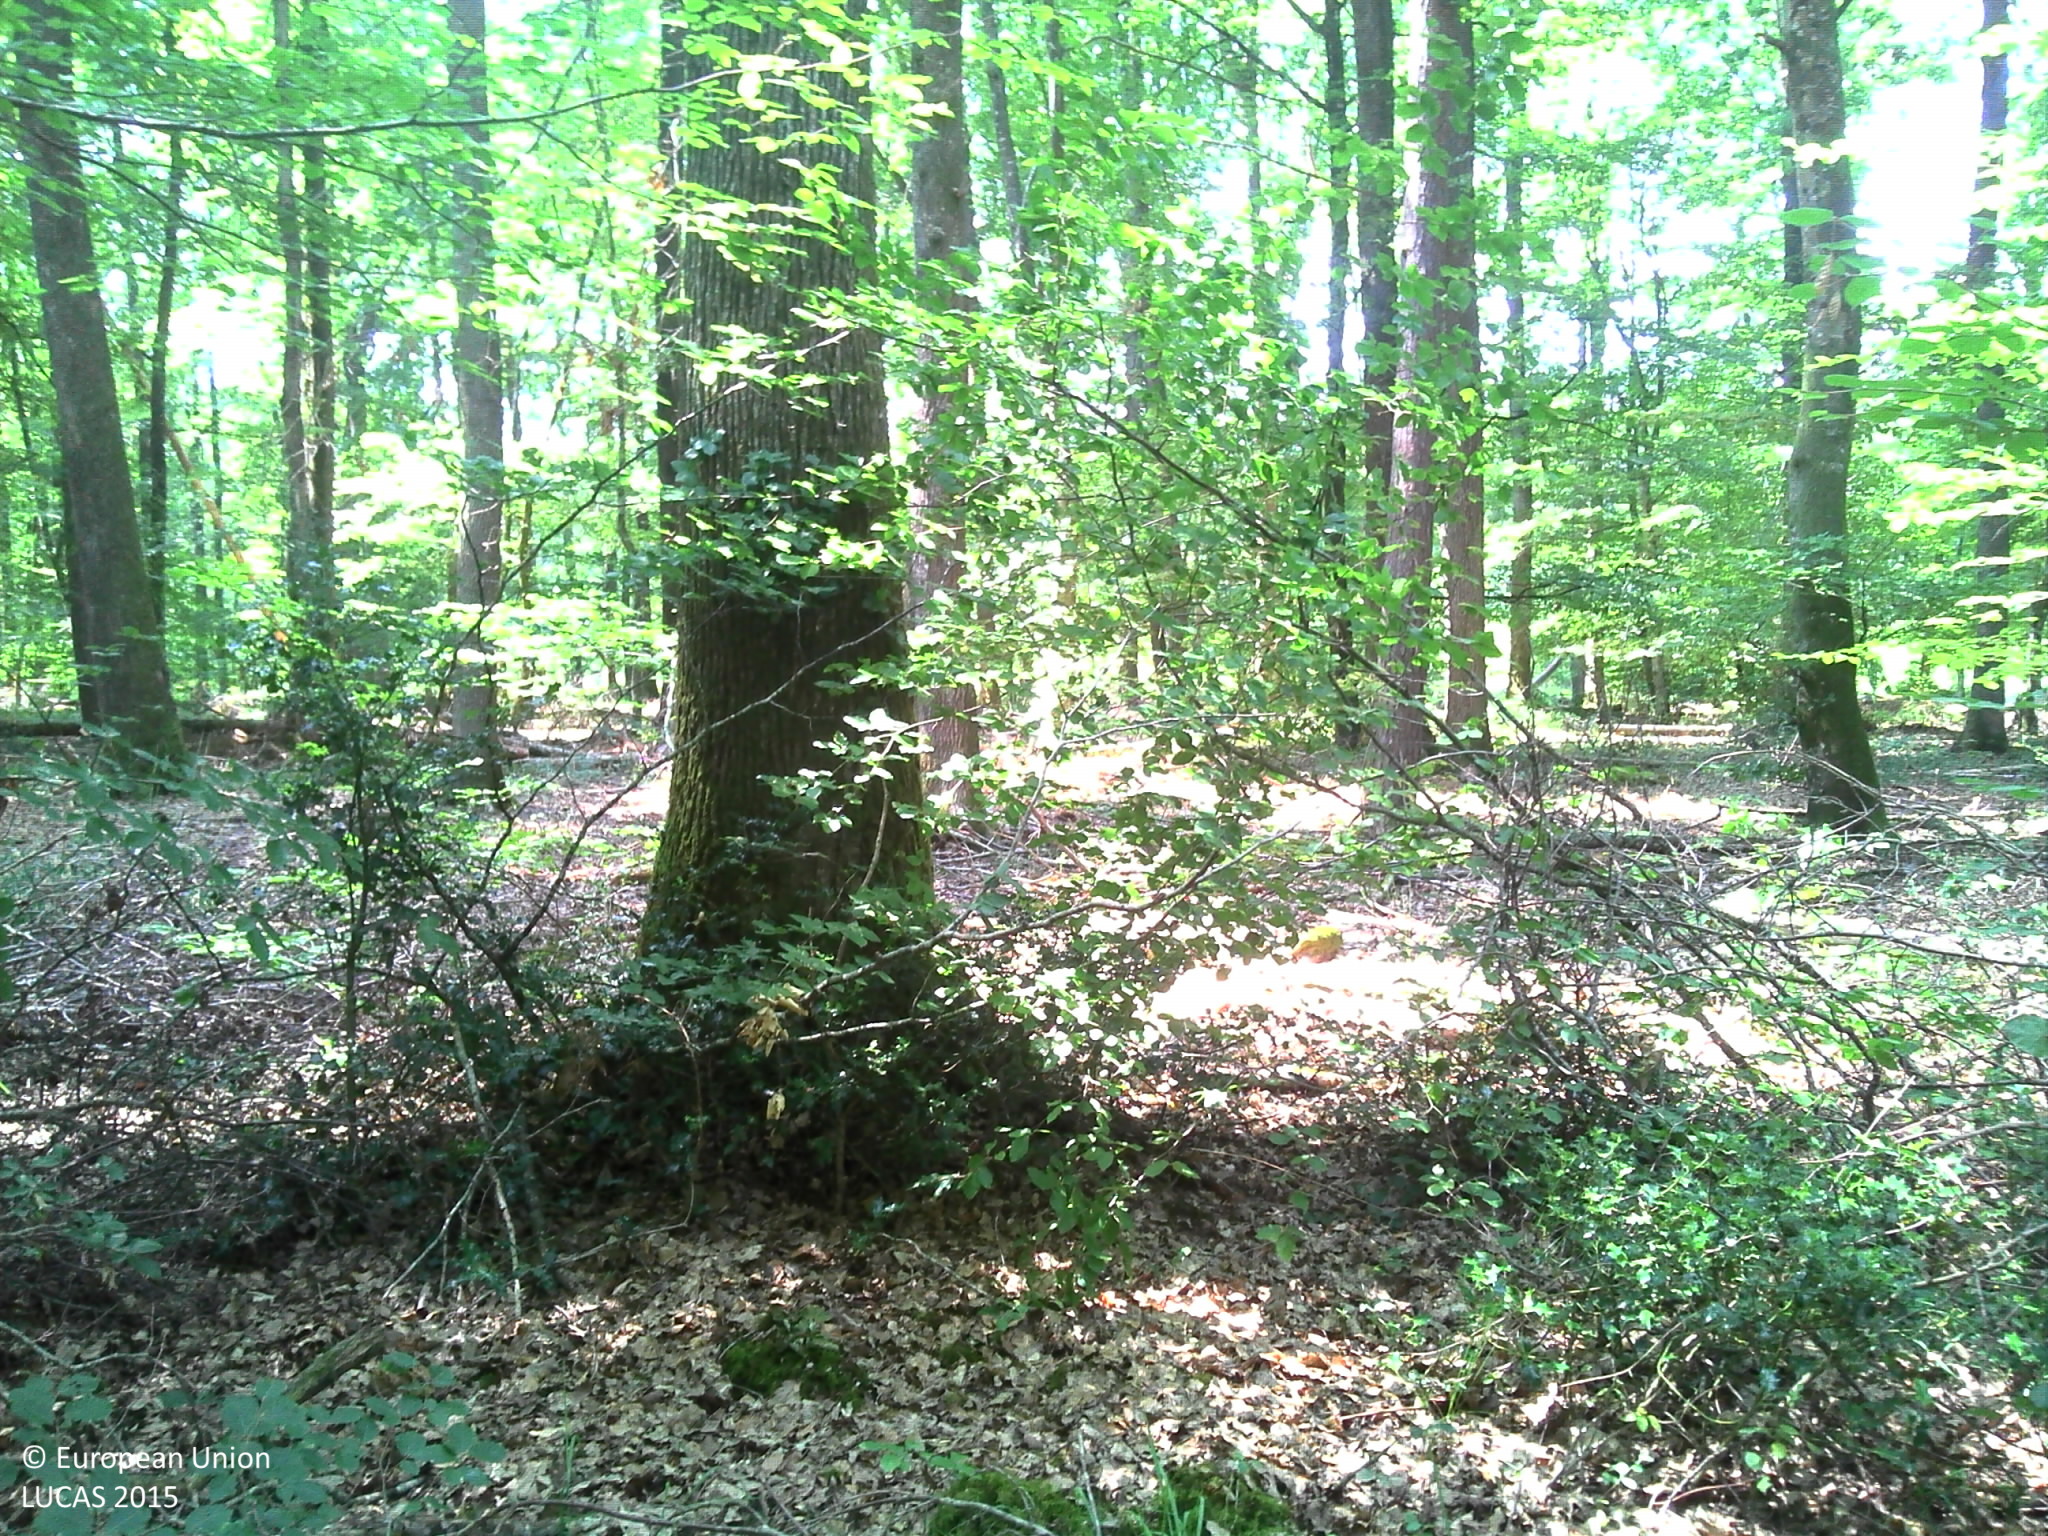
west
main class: Woodland
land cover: Broadleaved woodland
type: mesophytic deciduous forest
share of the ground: > 75 %
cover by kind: broadleaved forest trees 90 %, herbaceous plants 5 %, lichens and mosses 5 %
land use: Forestry
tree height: > 5 m
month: August
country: FR
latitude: 46.6811
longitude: 2.7134
